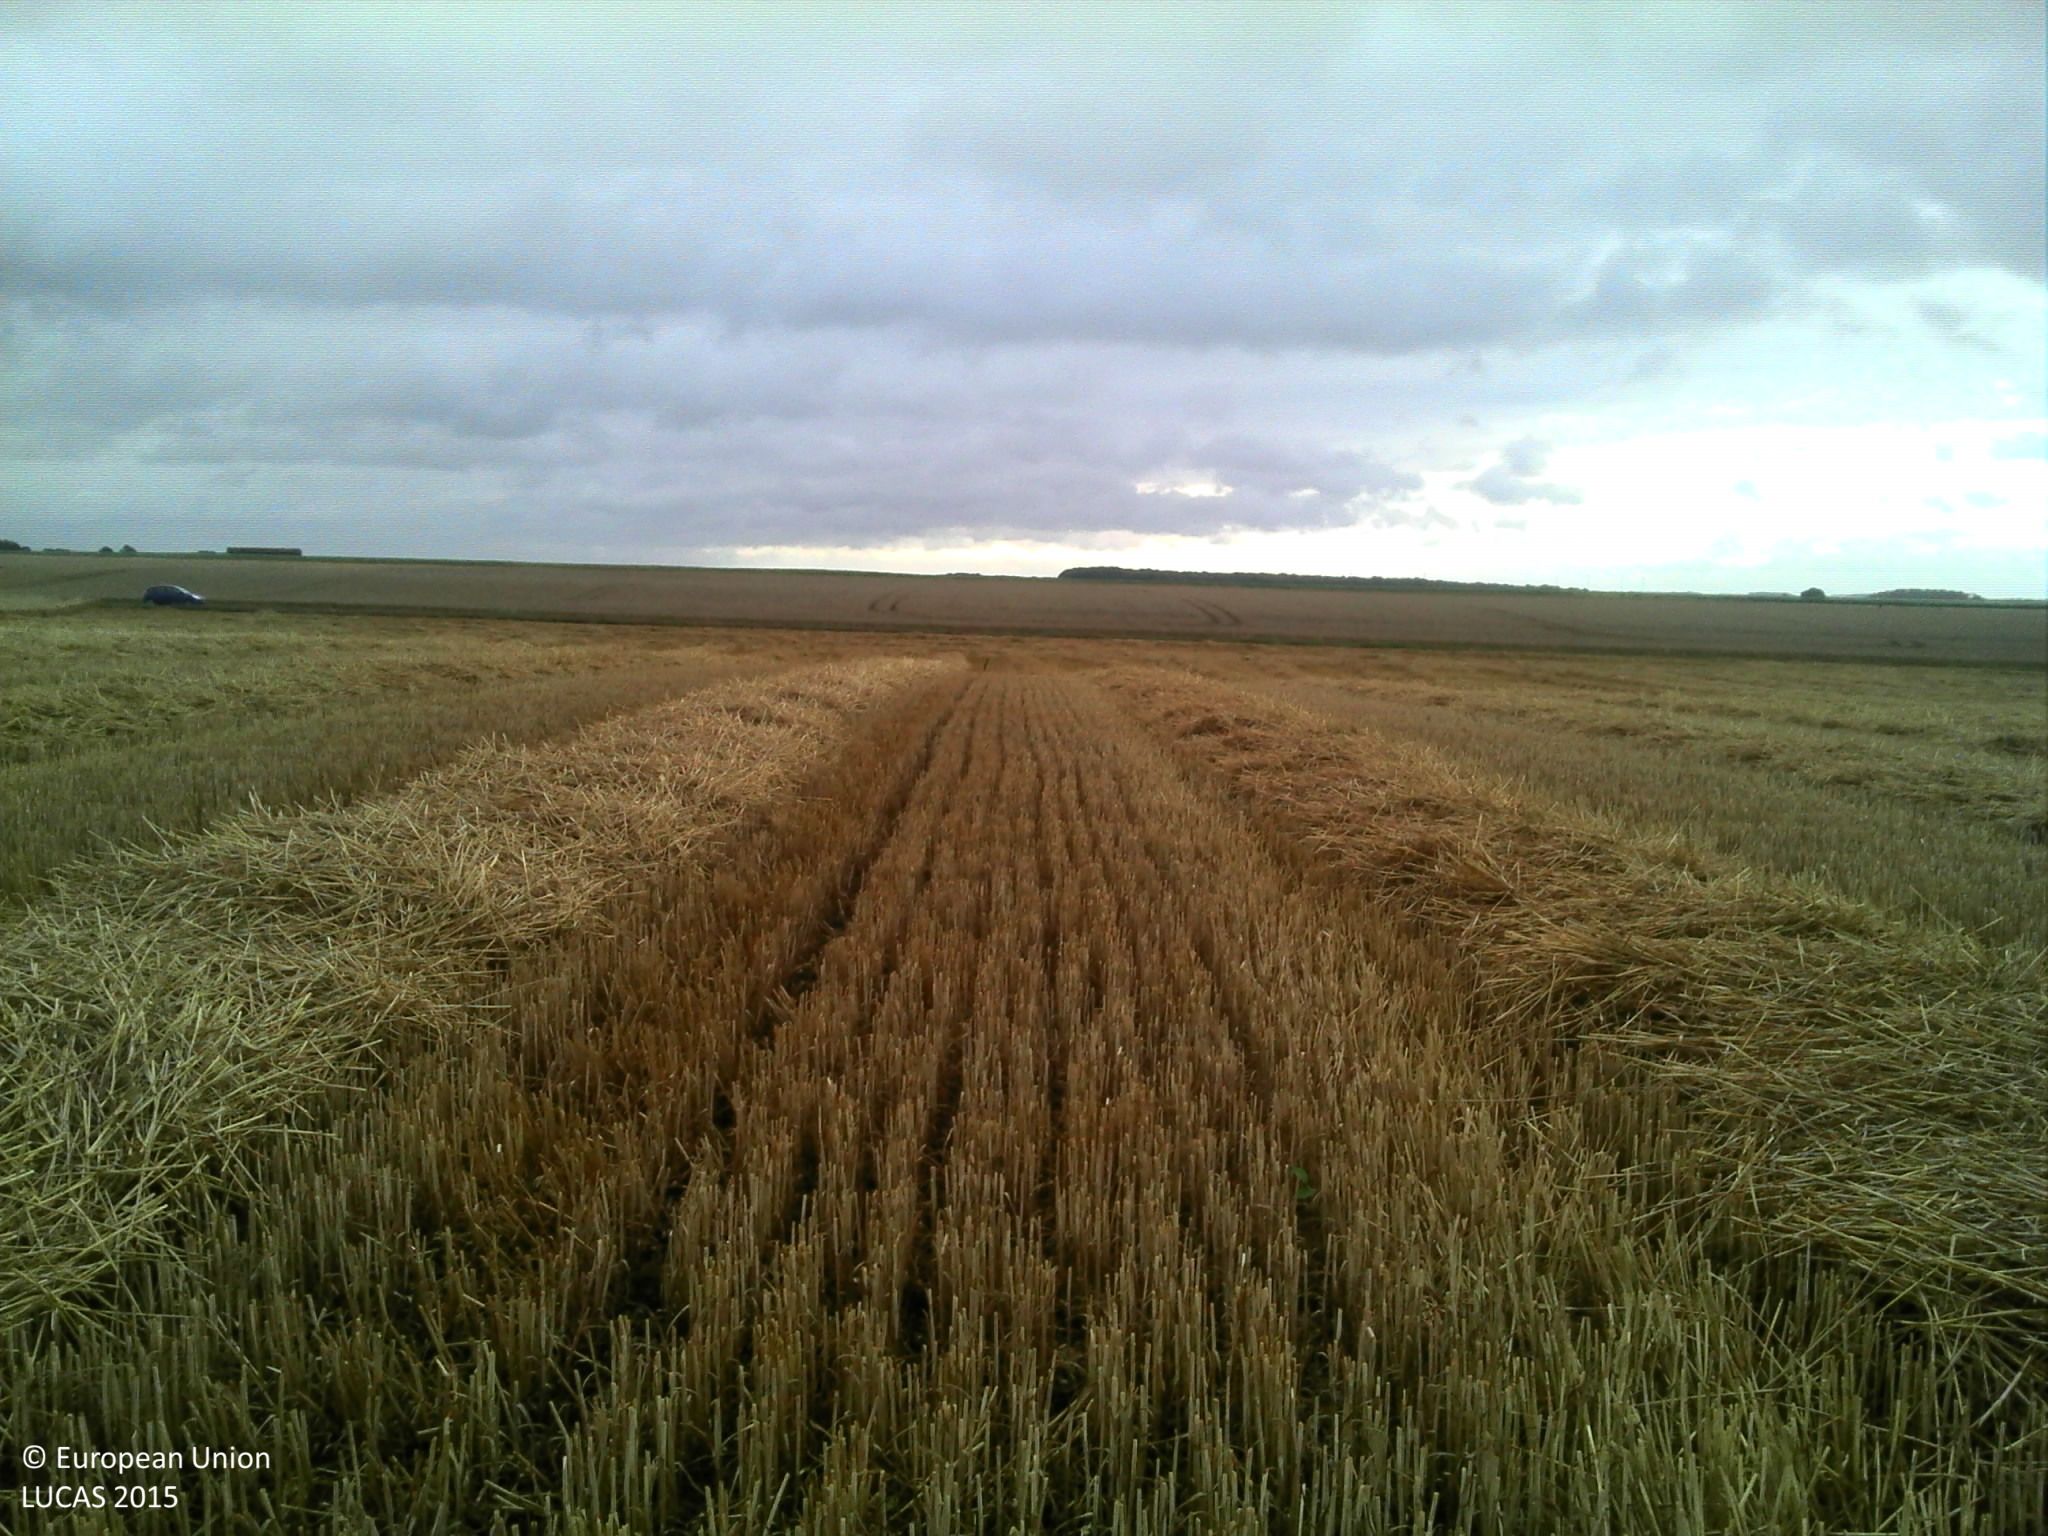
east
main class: Cropland
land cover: Common wheat
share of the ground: > 75 %
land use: Agriculture (excluding fallow land and kitchen gardens)
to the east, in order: Common wheat; Grass margins; Tracks; Common wheat
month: July
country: FR
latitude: 49.8444
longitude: 2.4643
